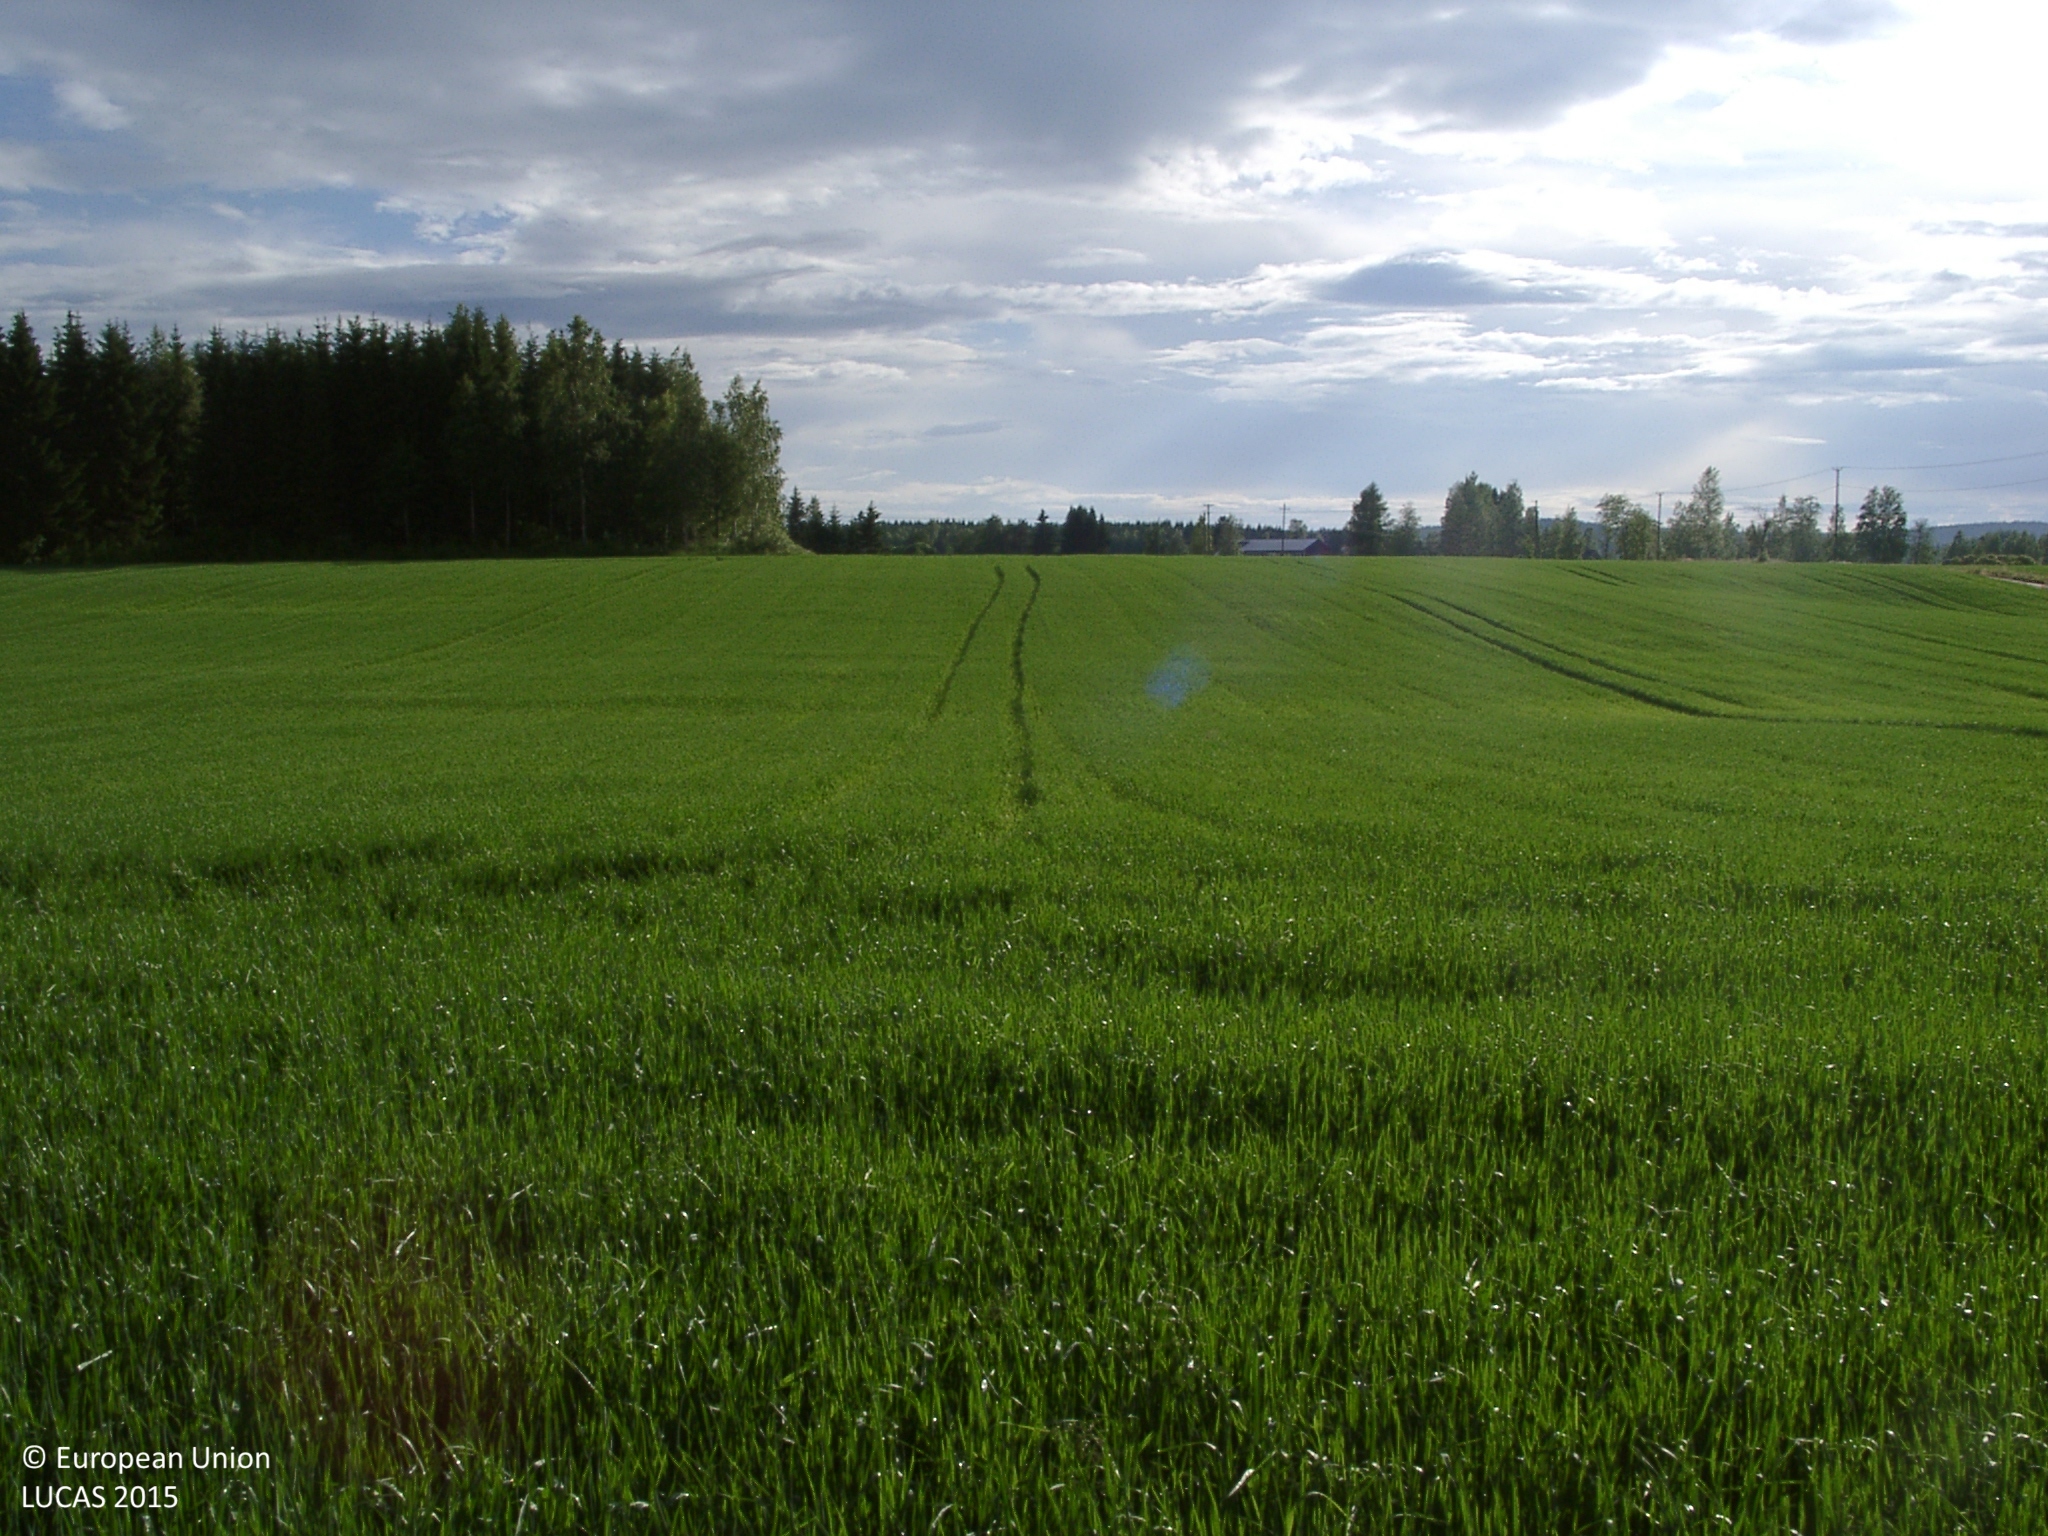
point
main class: Cropland
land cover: Oats
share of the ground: > 75 %
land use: Agriculture (excluding fallow land and kitchen gardens)
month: July
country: FI
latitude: 62.2028
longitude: 25.1965
